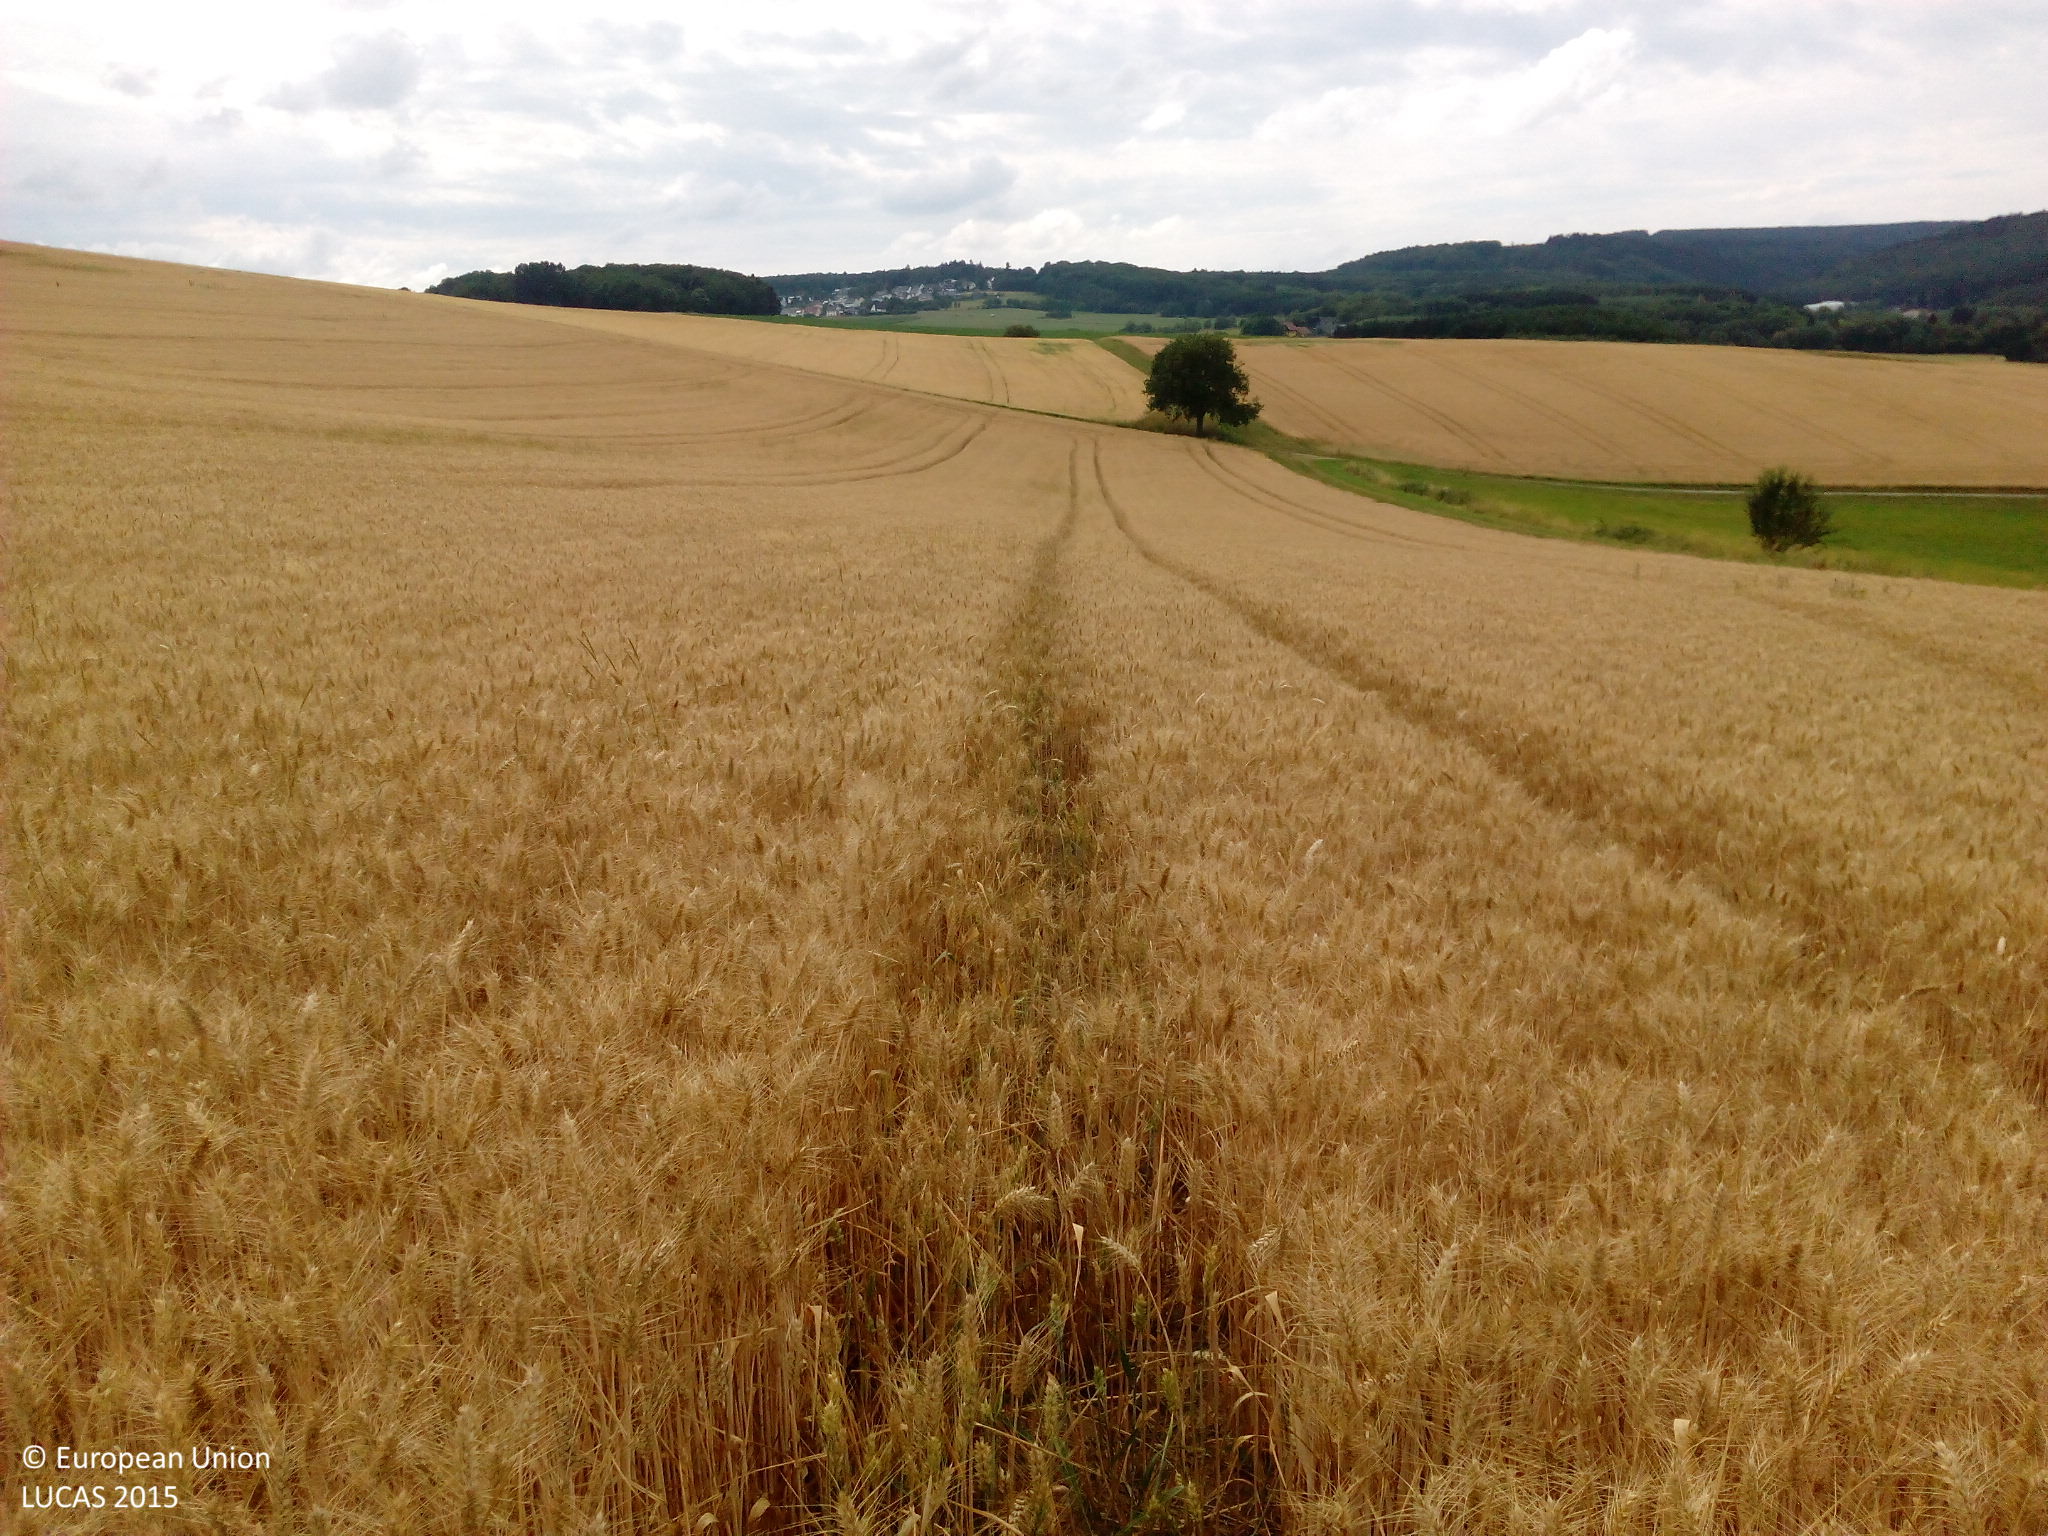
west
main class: Cropland
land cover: Common wheat
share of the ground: > 75 %
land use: Agriculture (excluding fallow land and kitchen gardens)
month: July
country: DE
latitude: 49.6997
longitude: 7.1857
